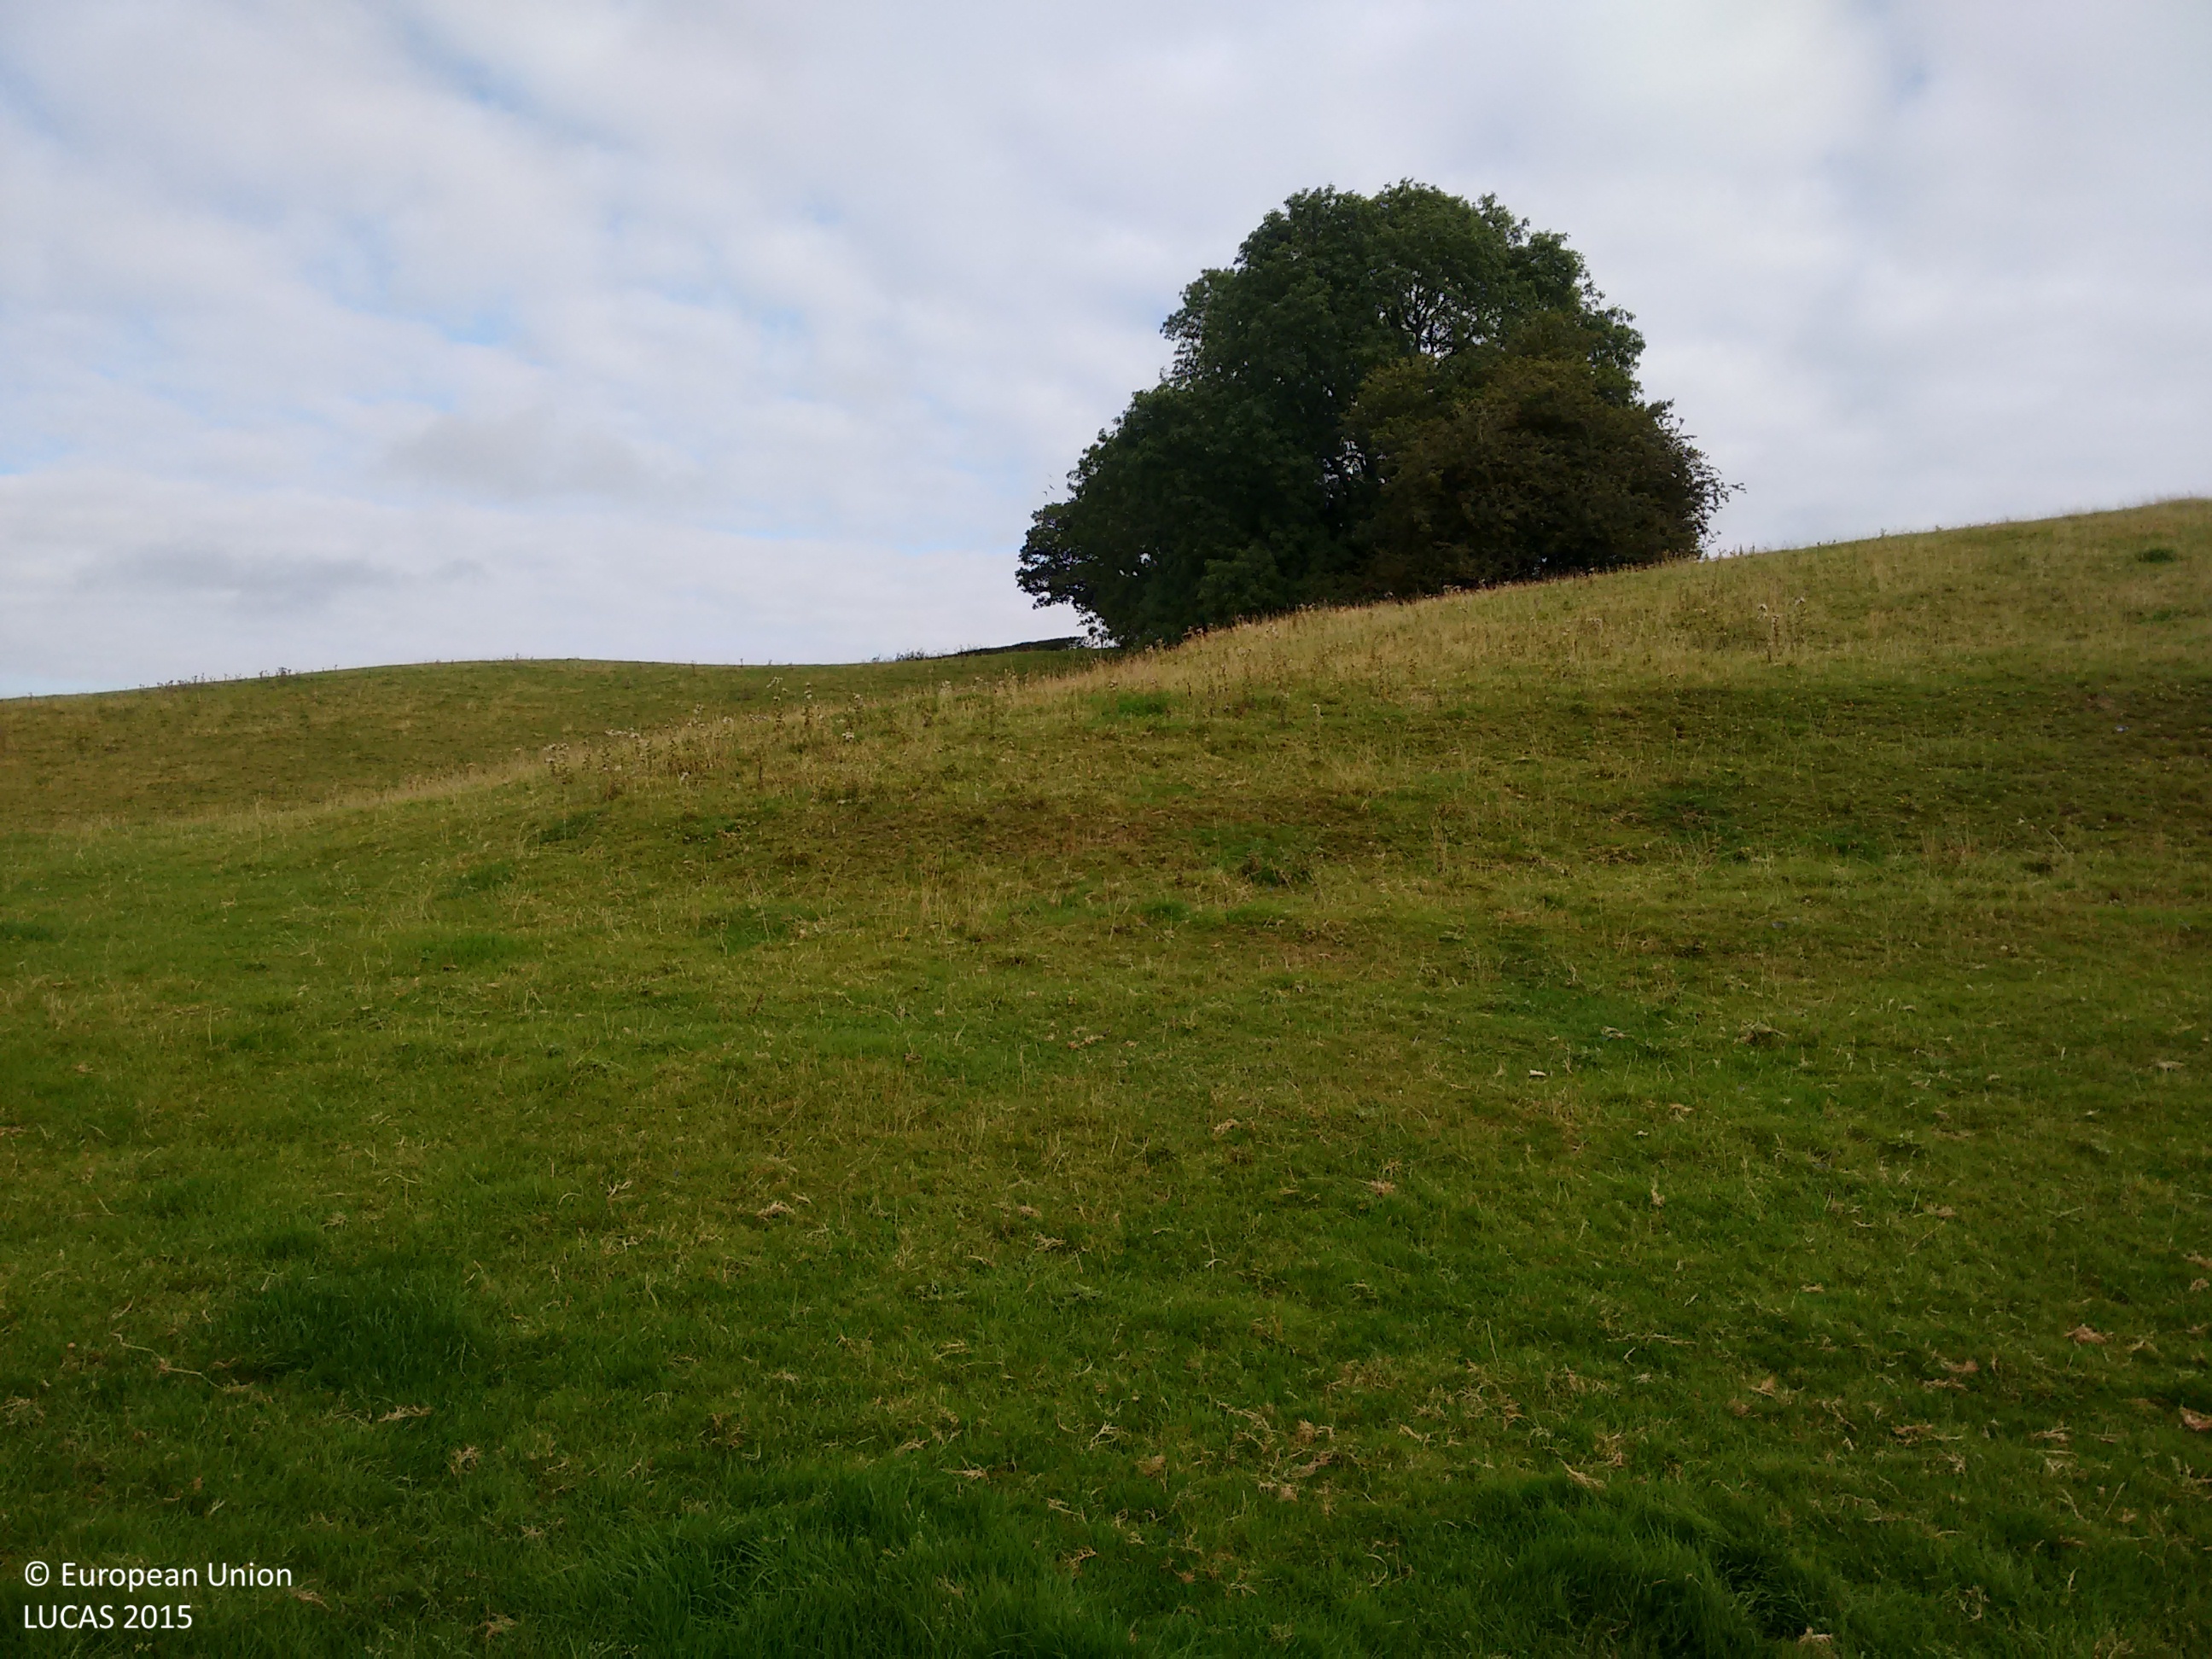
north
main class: Grassland
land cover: Grassland without tree/shrub cover
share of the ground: > 75 %
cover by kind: herbaceous plants 100 %
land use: Agriculture (excluding fallow land and kitchen gardens)
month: September
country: GB
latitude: 52.8728
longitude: -2.8944
